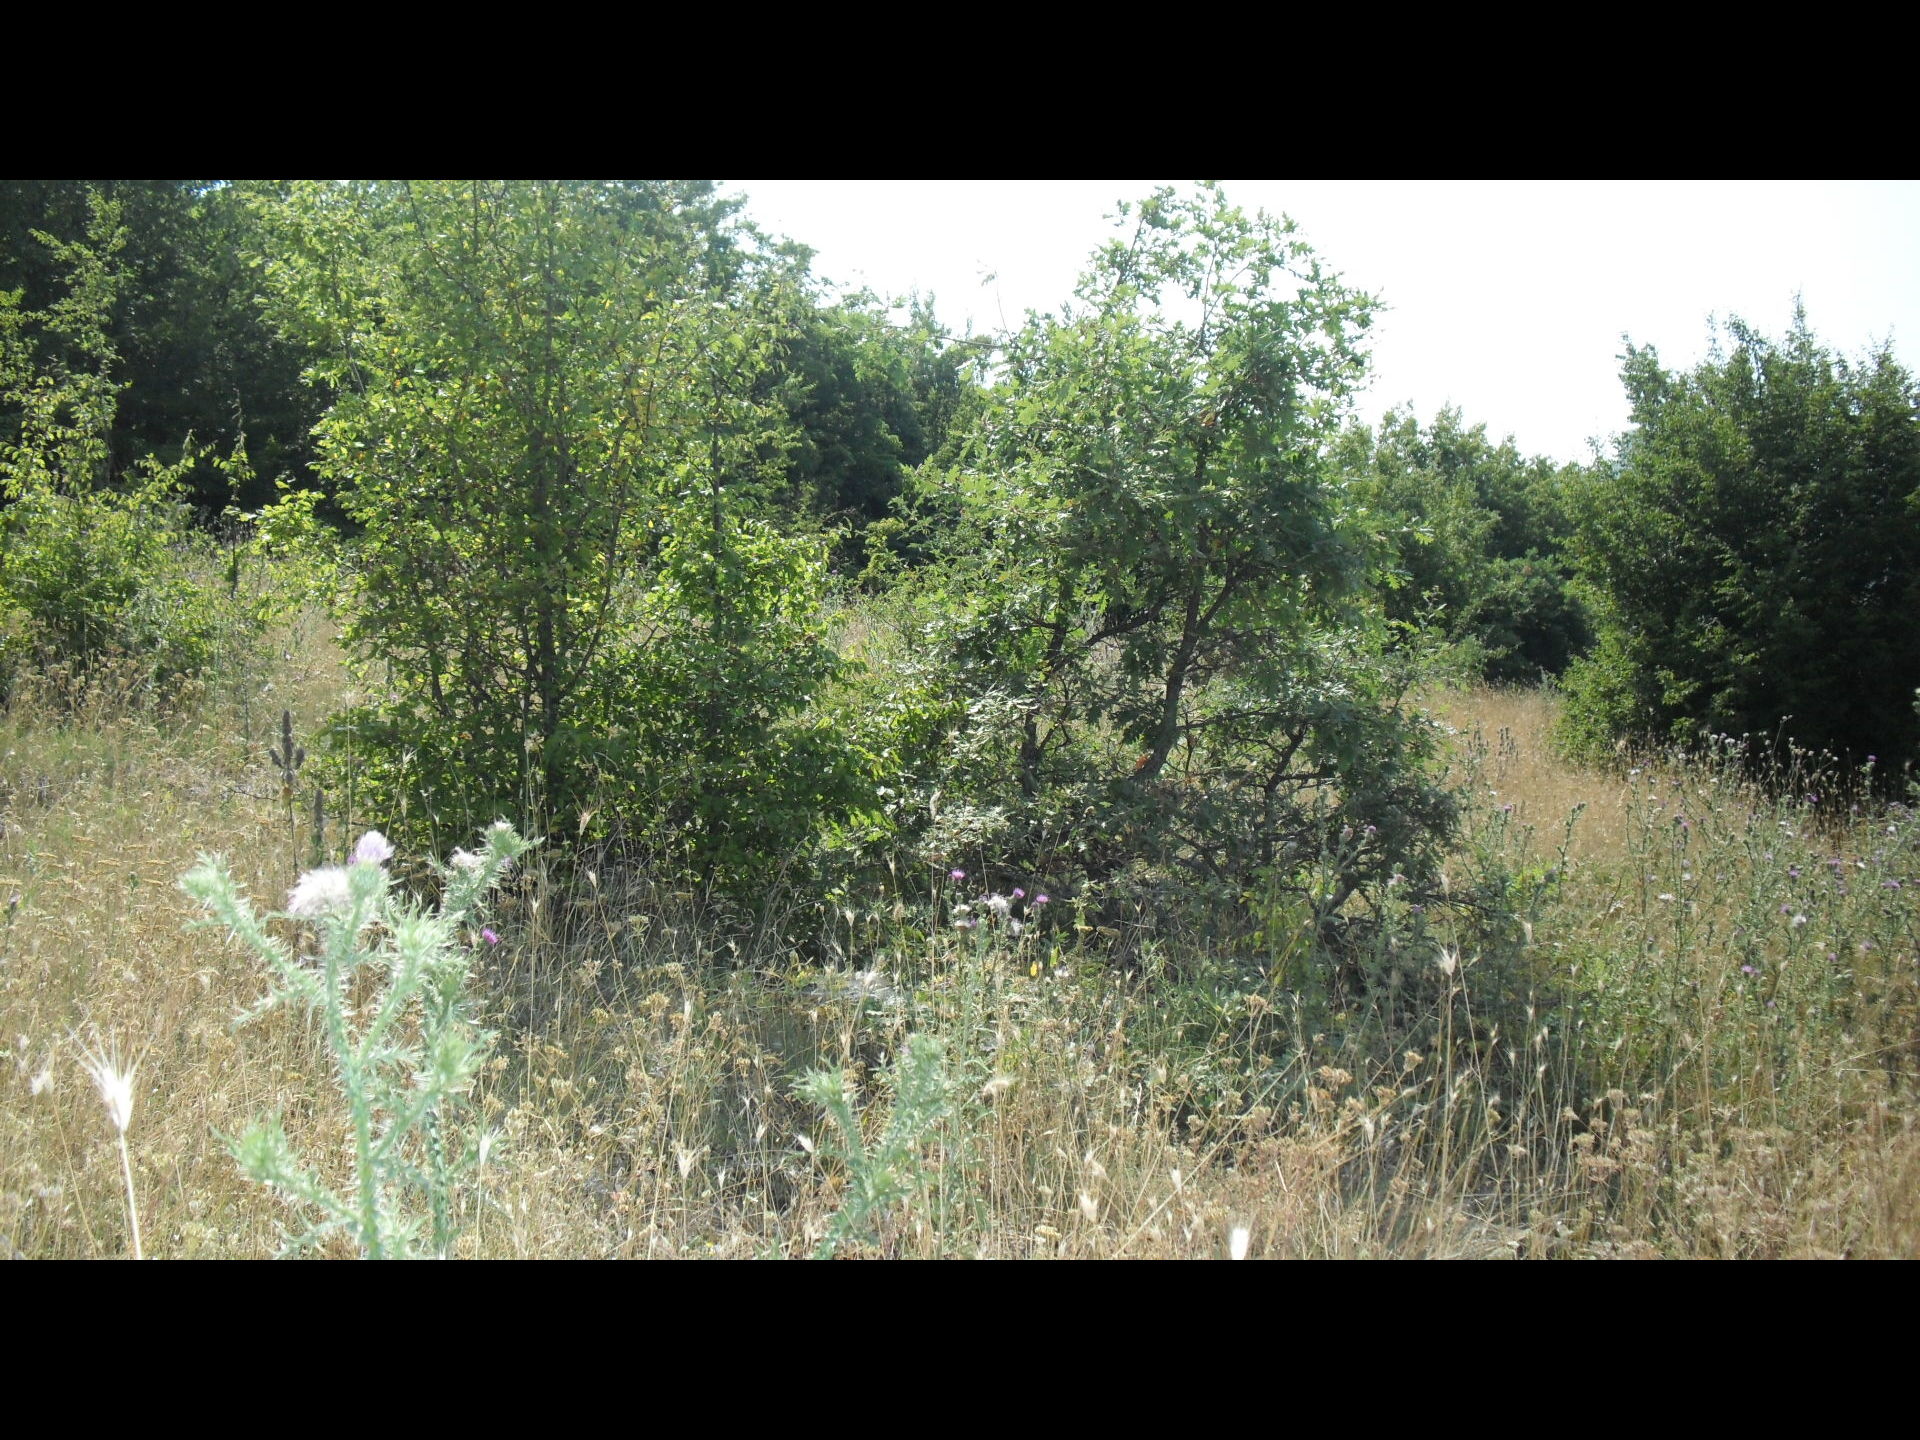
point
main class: Woodland
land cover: Broadleaved woodland
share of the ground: 25 - 50 %
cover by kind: herbaceous plants 50 %, broadleaved forest trees 25 %, shrubs 25 %
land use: Semi-natural and natural areas not in use
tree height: < 5 m
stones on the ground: 10 - 25 %
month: July
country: BG
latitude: 43.6139
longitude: 22.7602
